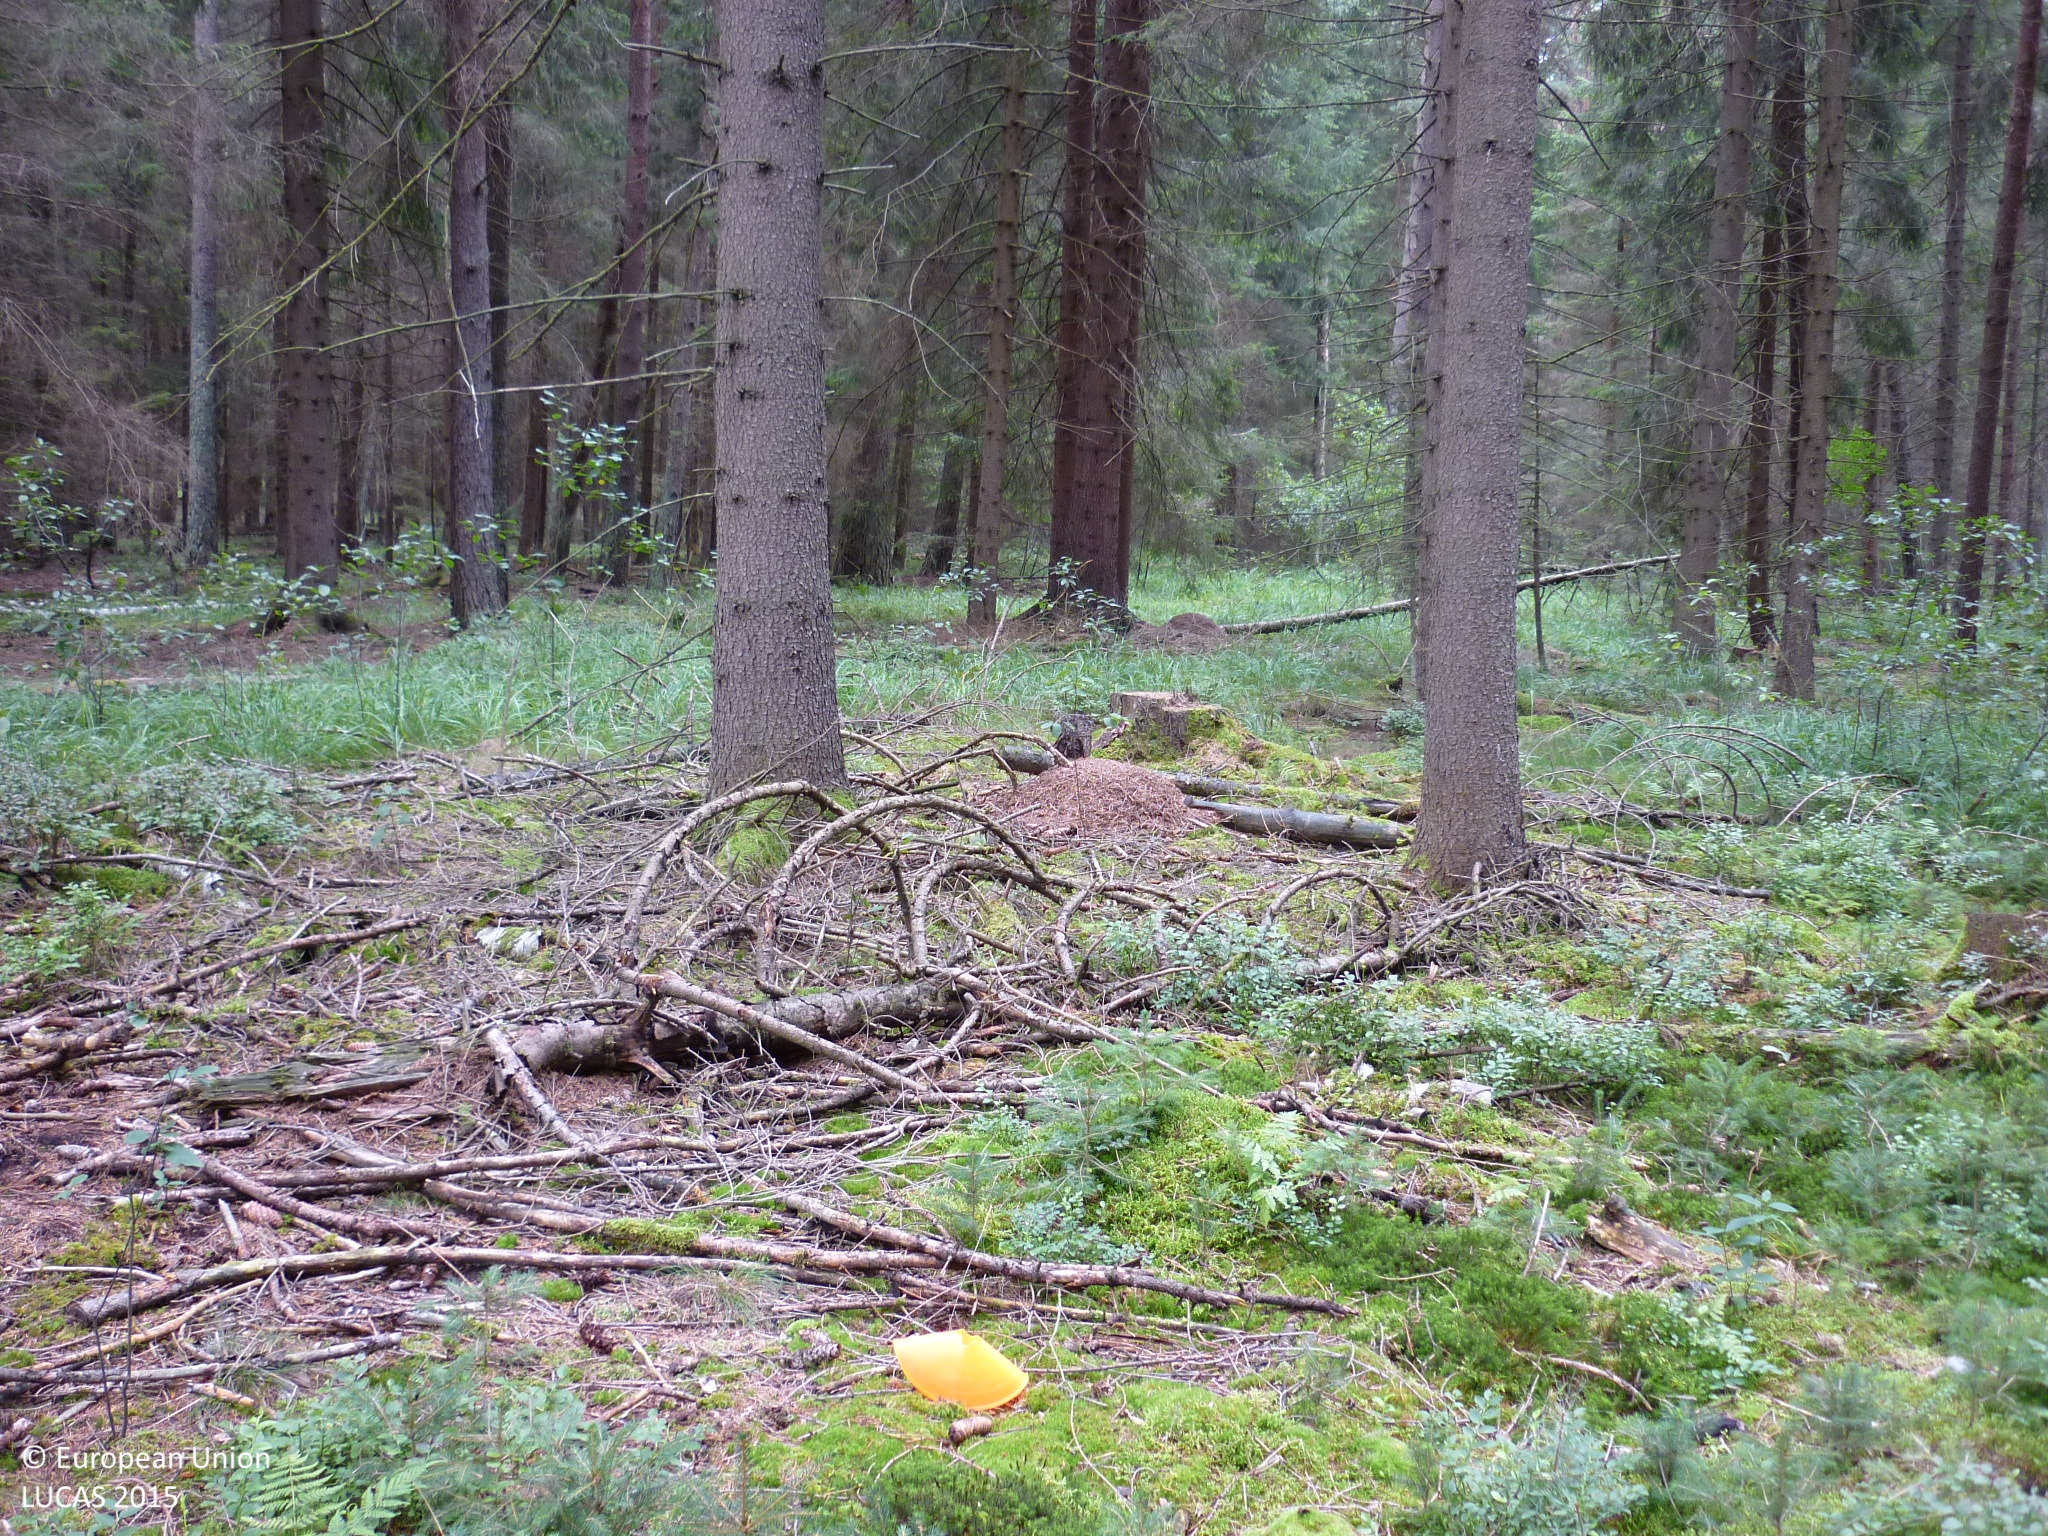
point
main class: Woodland
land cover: Spruce dominated coniferous woodland
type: hemiboreal forest and nemoral coniferous forest and mixed broadleaved-coniferous forest
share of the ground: > 75 %
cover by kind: coniferous forest trees 95 %, lichens and mosses 5 %
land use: Forestry
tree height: > 5 m
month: September
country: AT
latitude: 48.8262
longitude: 15.1102
